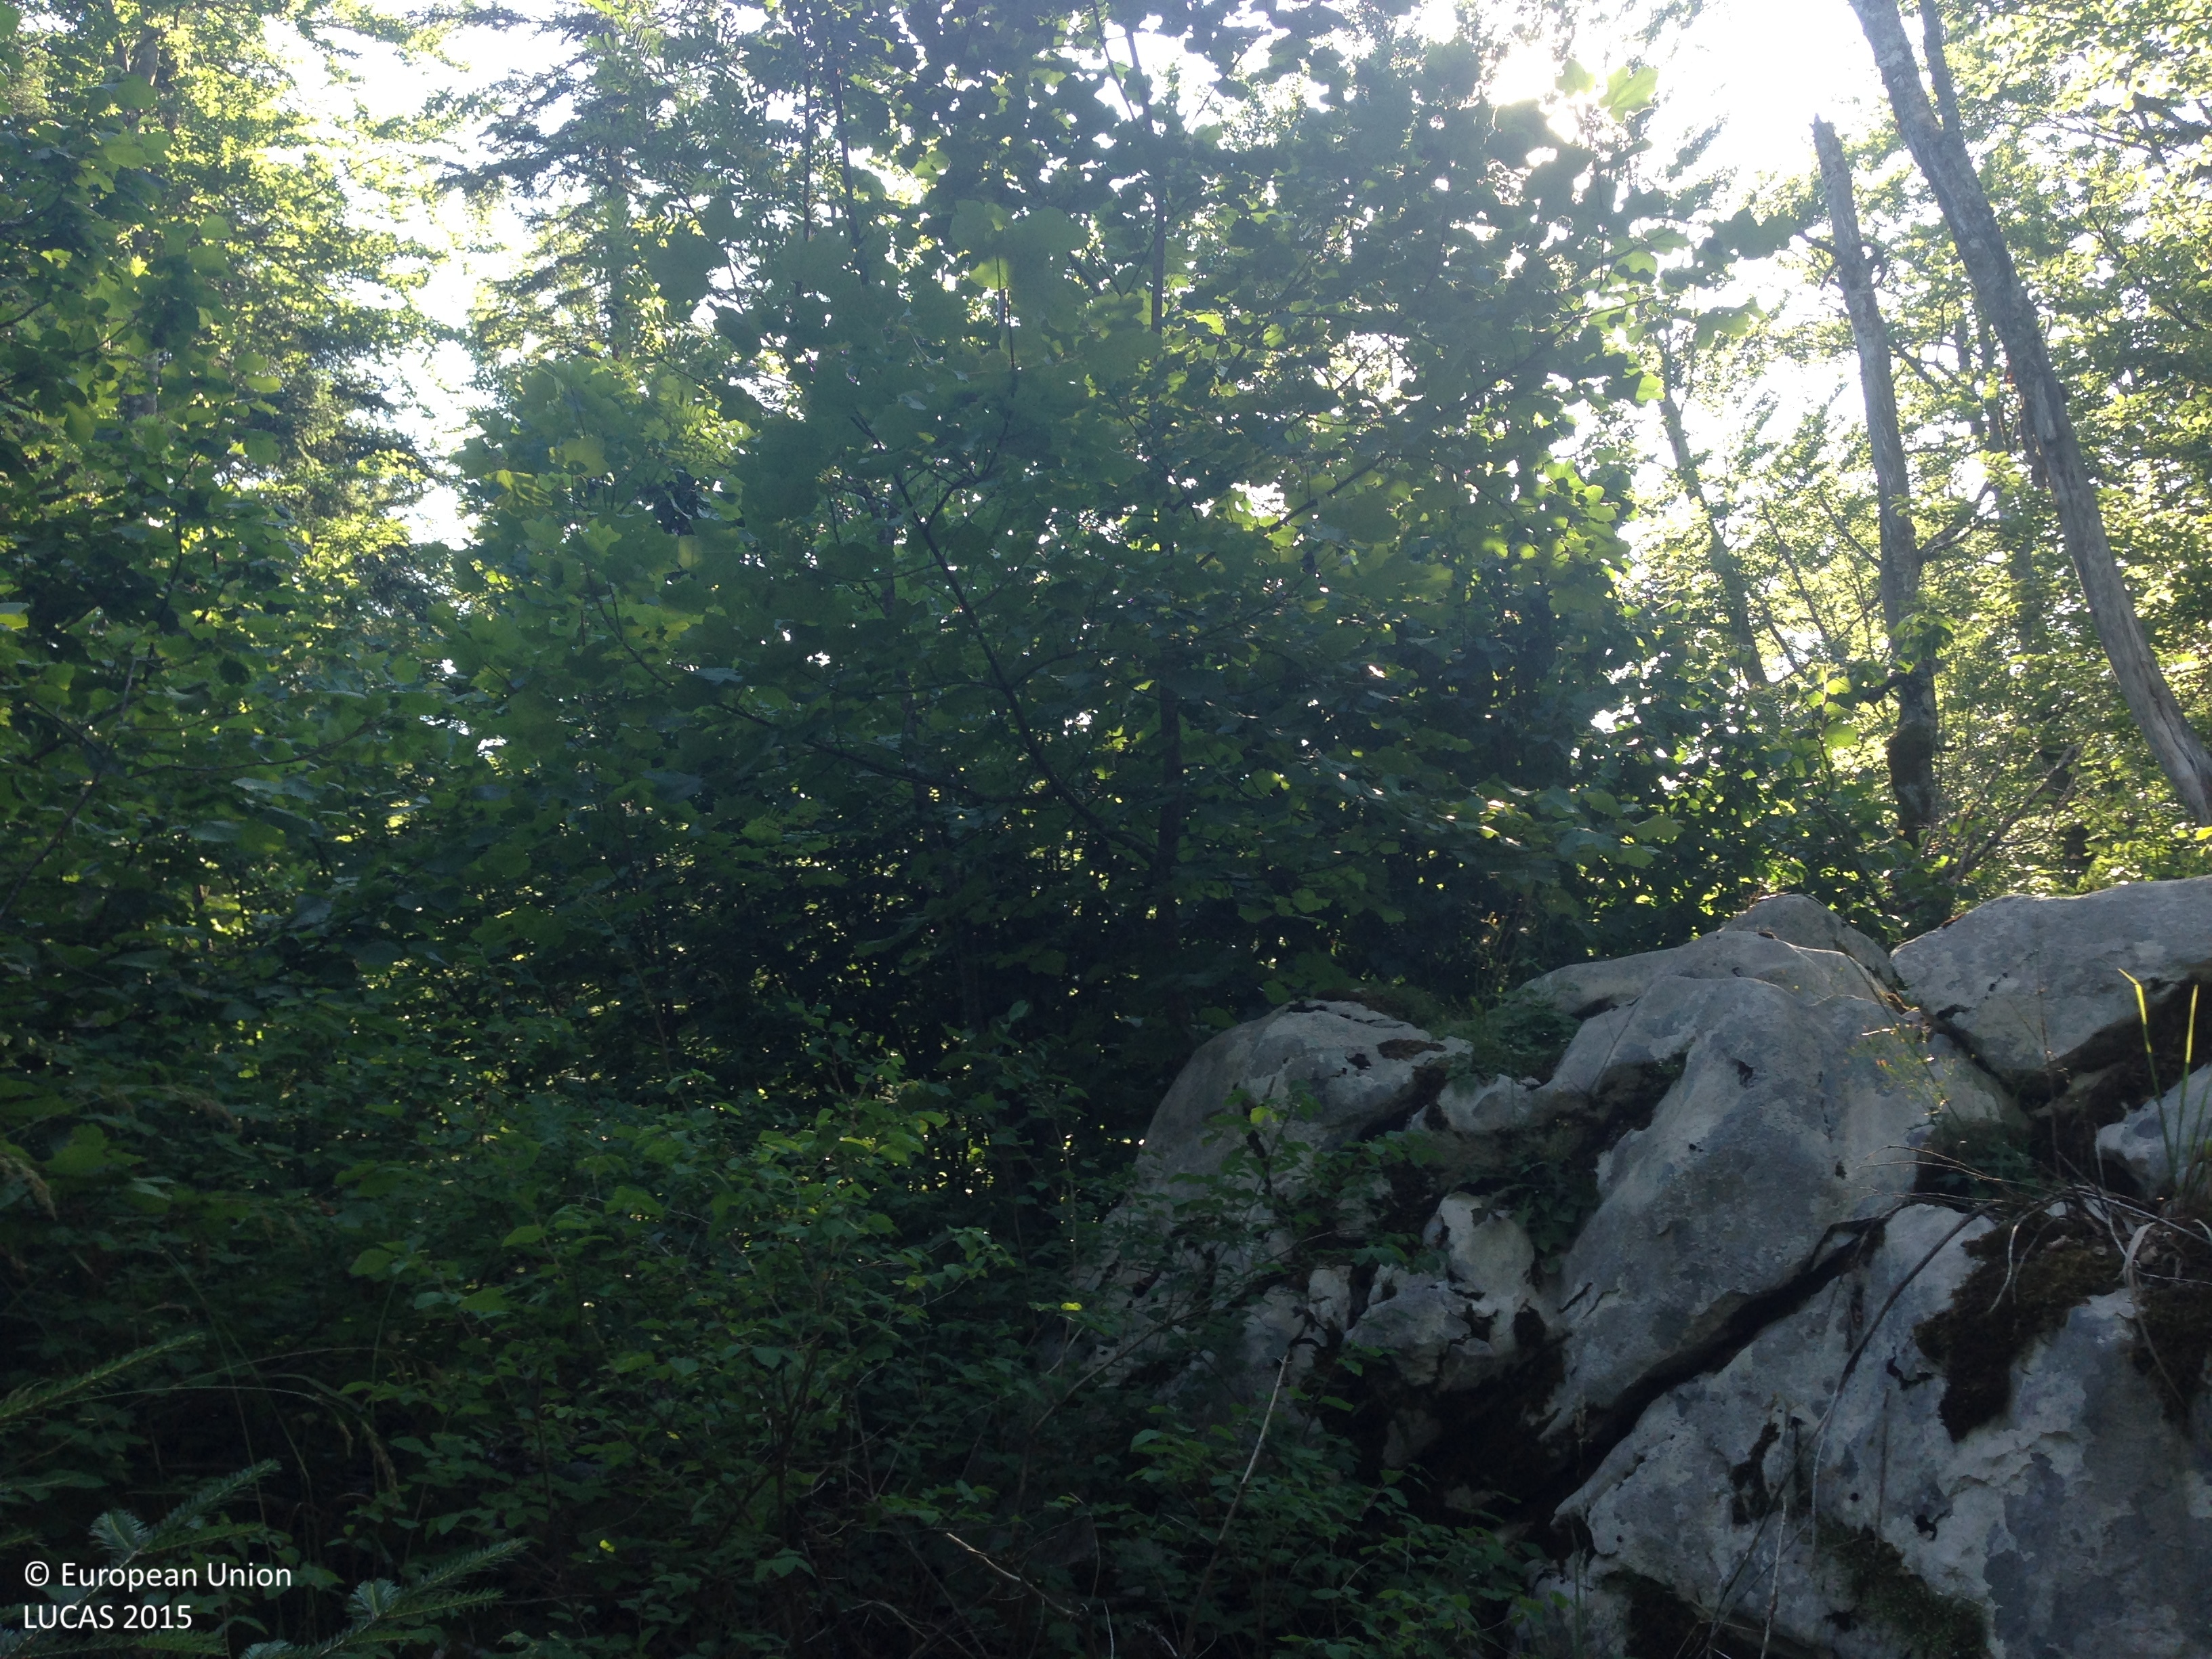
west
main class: Woodland
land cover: Other mixed woodland
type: thermophilous deciduous forest
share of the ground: > 75 %
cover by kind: broadleaved forest trees 35 %, coniferous forest trees 20 %, consolidated bare surface 15 %, shrubs 10 %, herbaceous plants 10 %, lichens and mosses 10 %
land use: Forestry
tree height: > 5 m
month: July
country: HR
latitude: 44.7294
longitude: 15.1327
